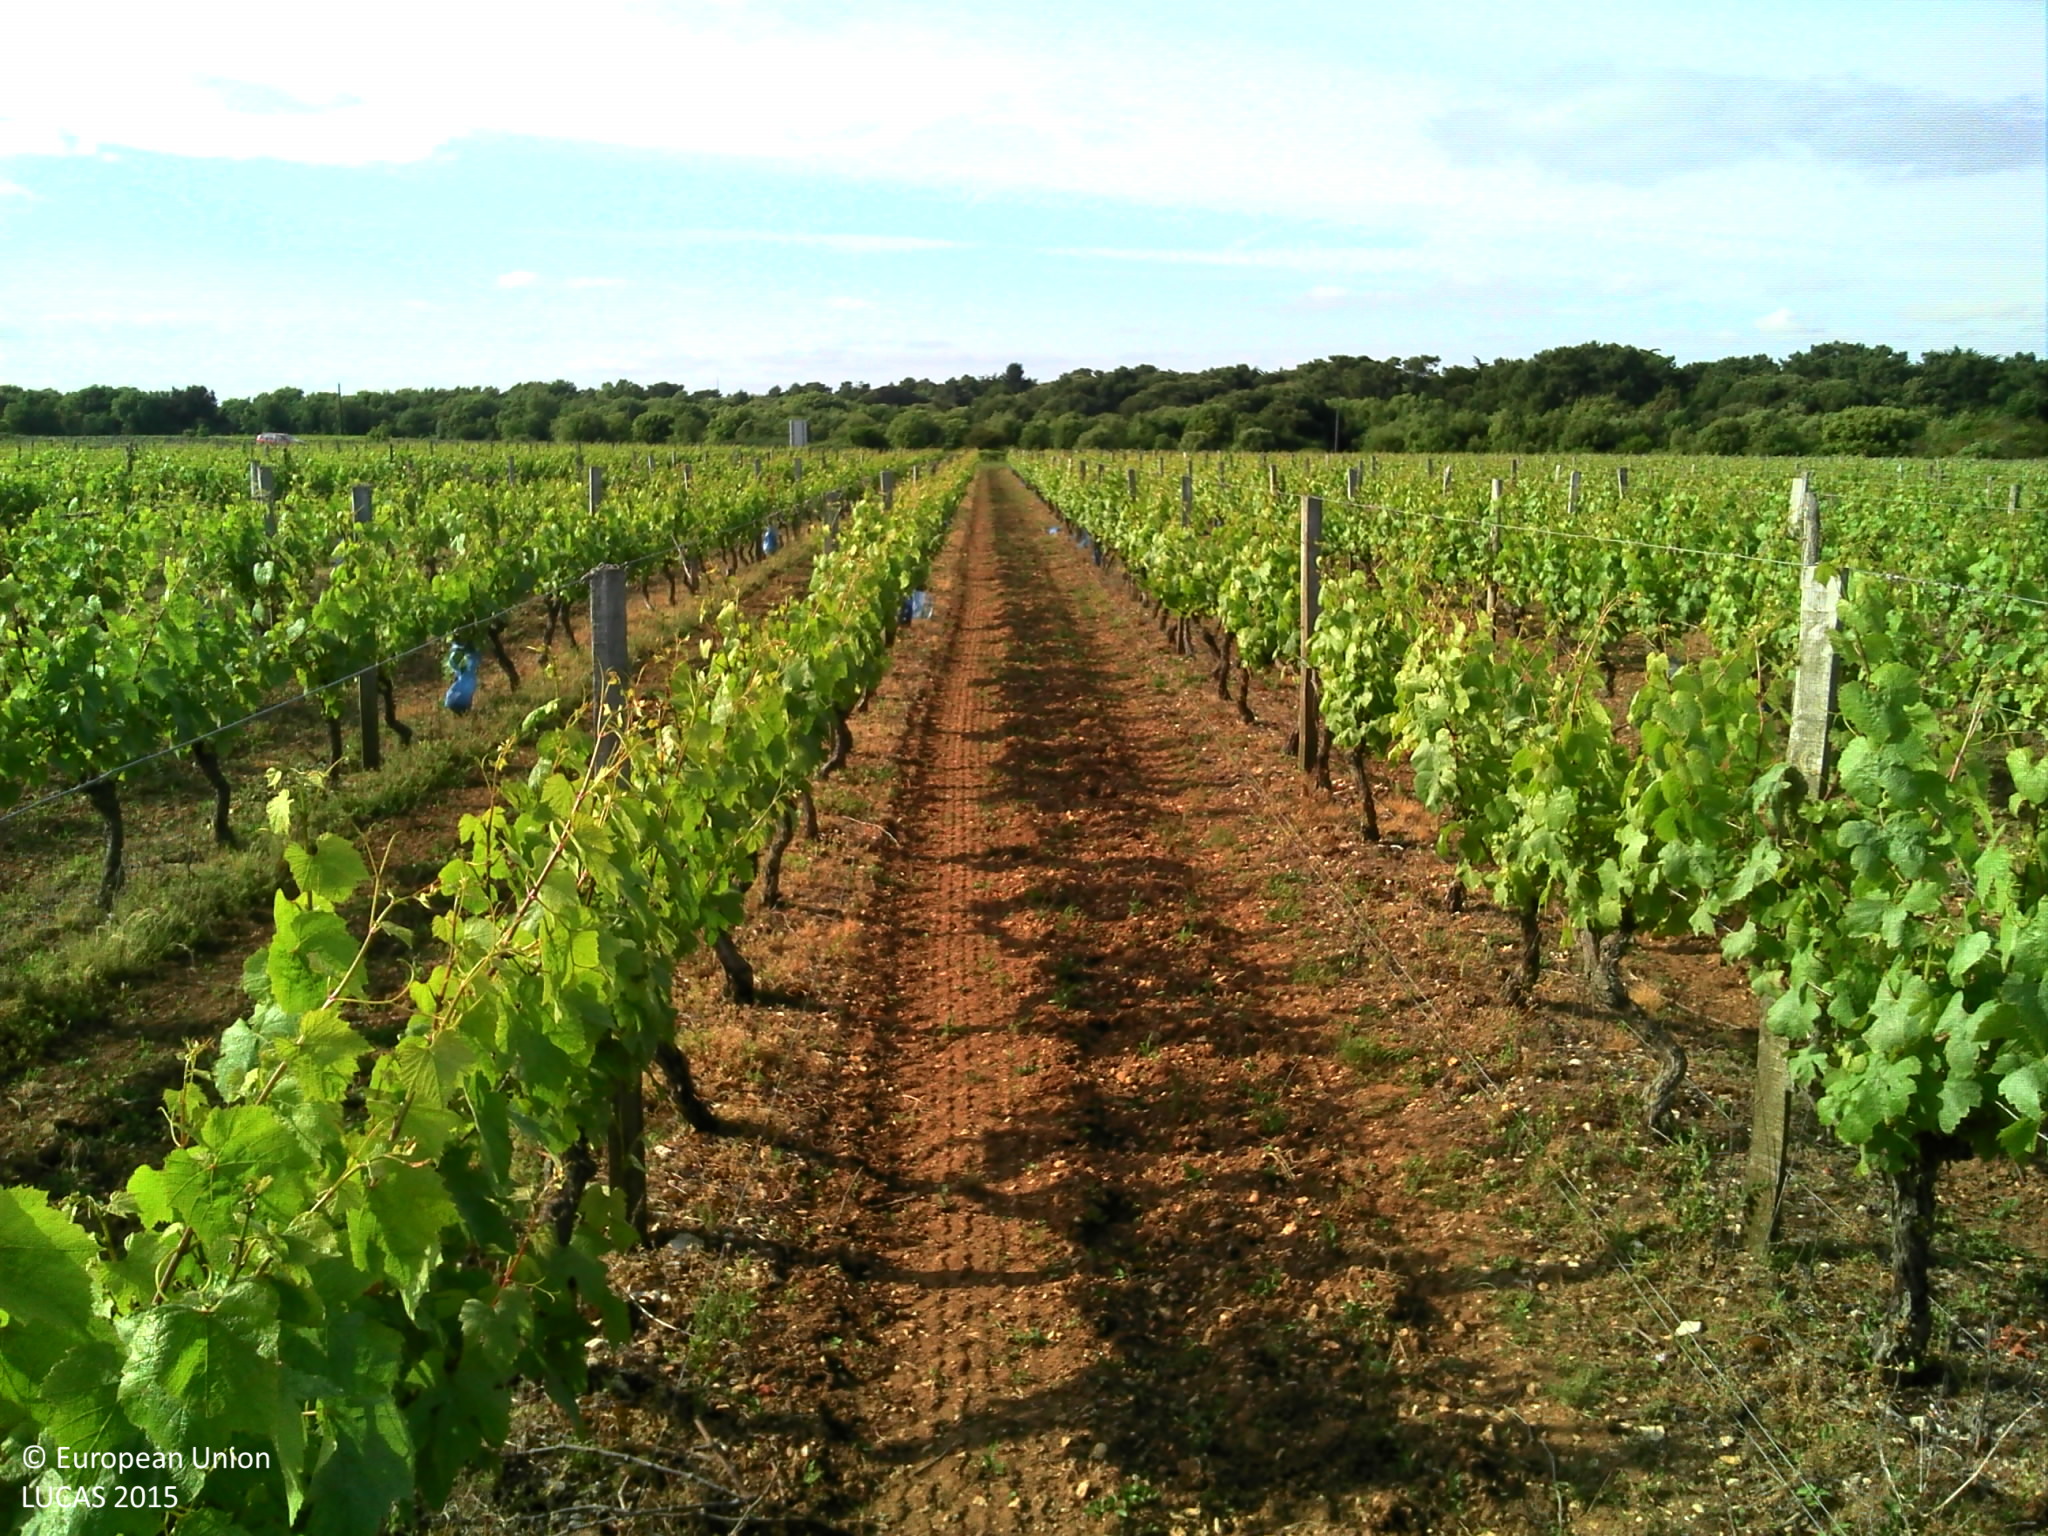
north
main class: Cropland
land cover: Vineyards
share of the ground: 25 - 50 %
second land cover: Other bare soil
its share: > 75 %
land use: Agriculture (excluding fallow land and kitchen gardens)
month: May
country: FR
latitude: 46.1519
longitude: -1.2851
